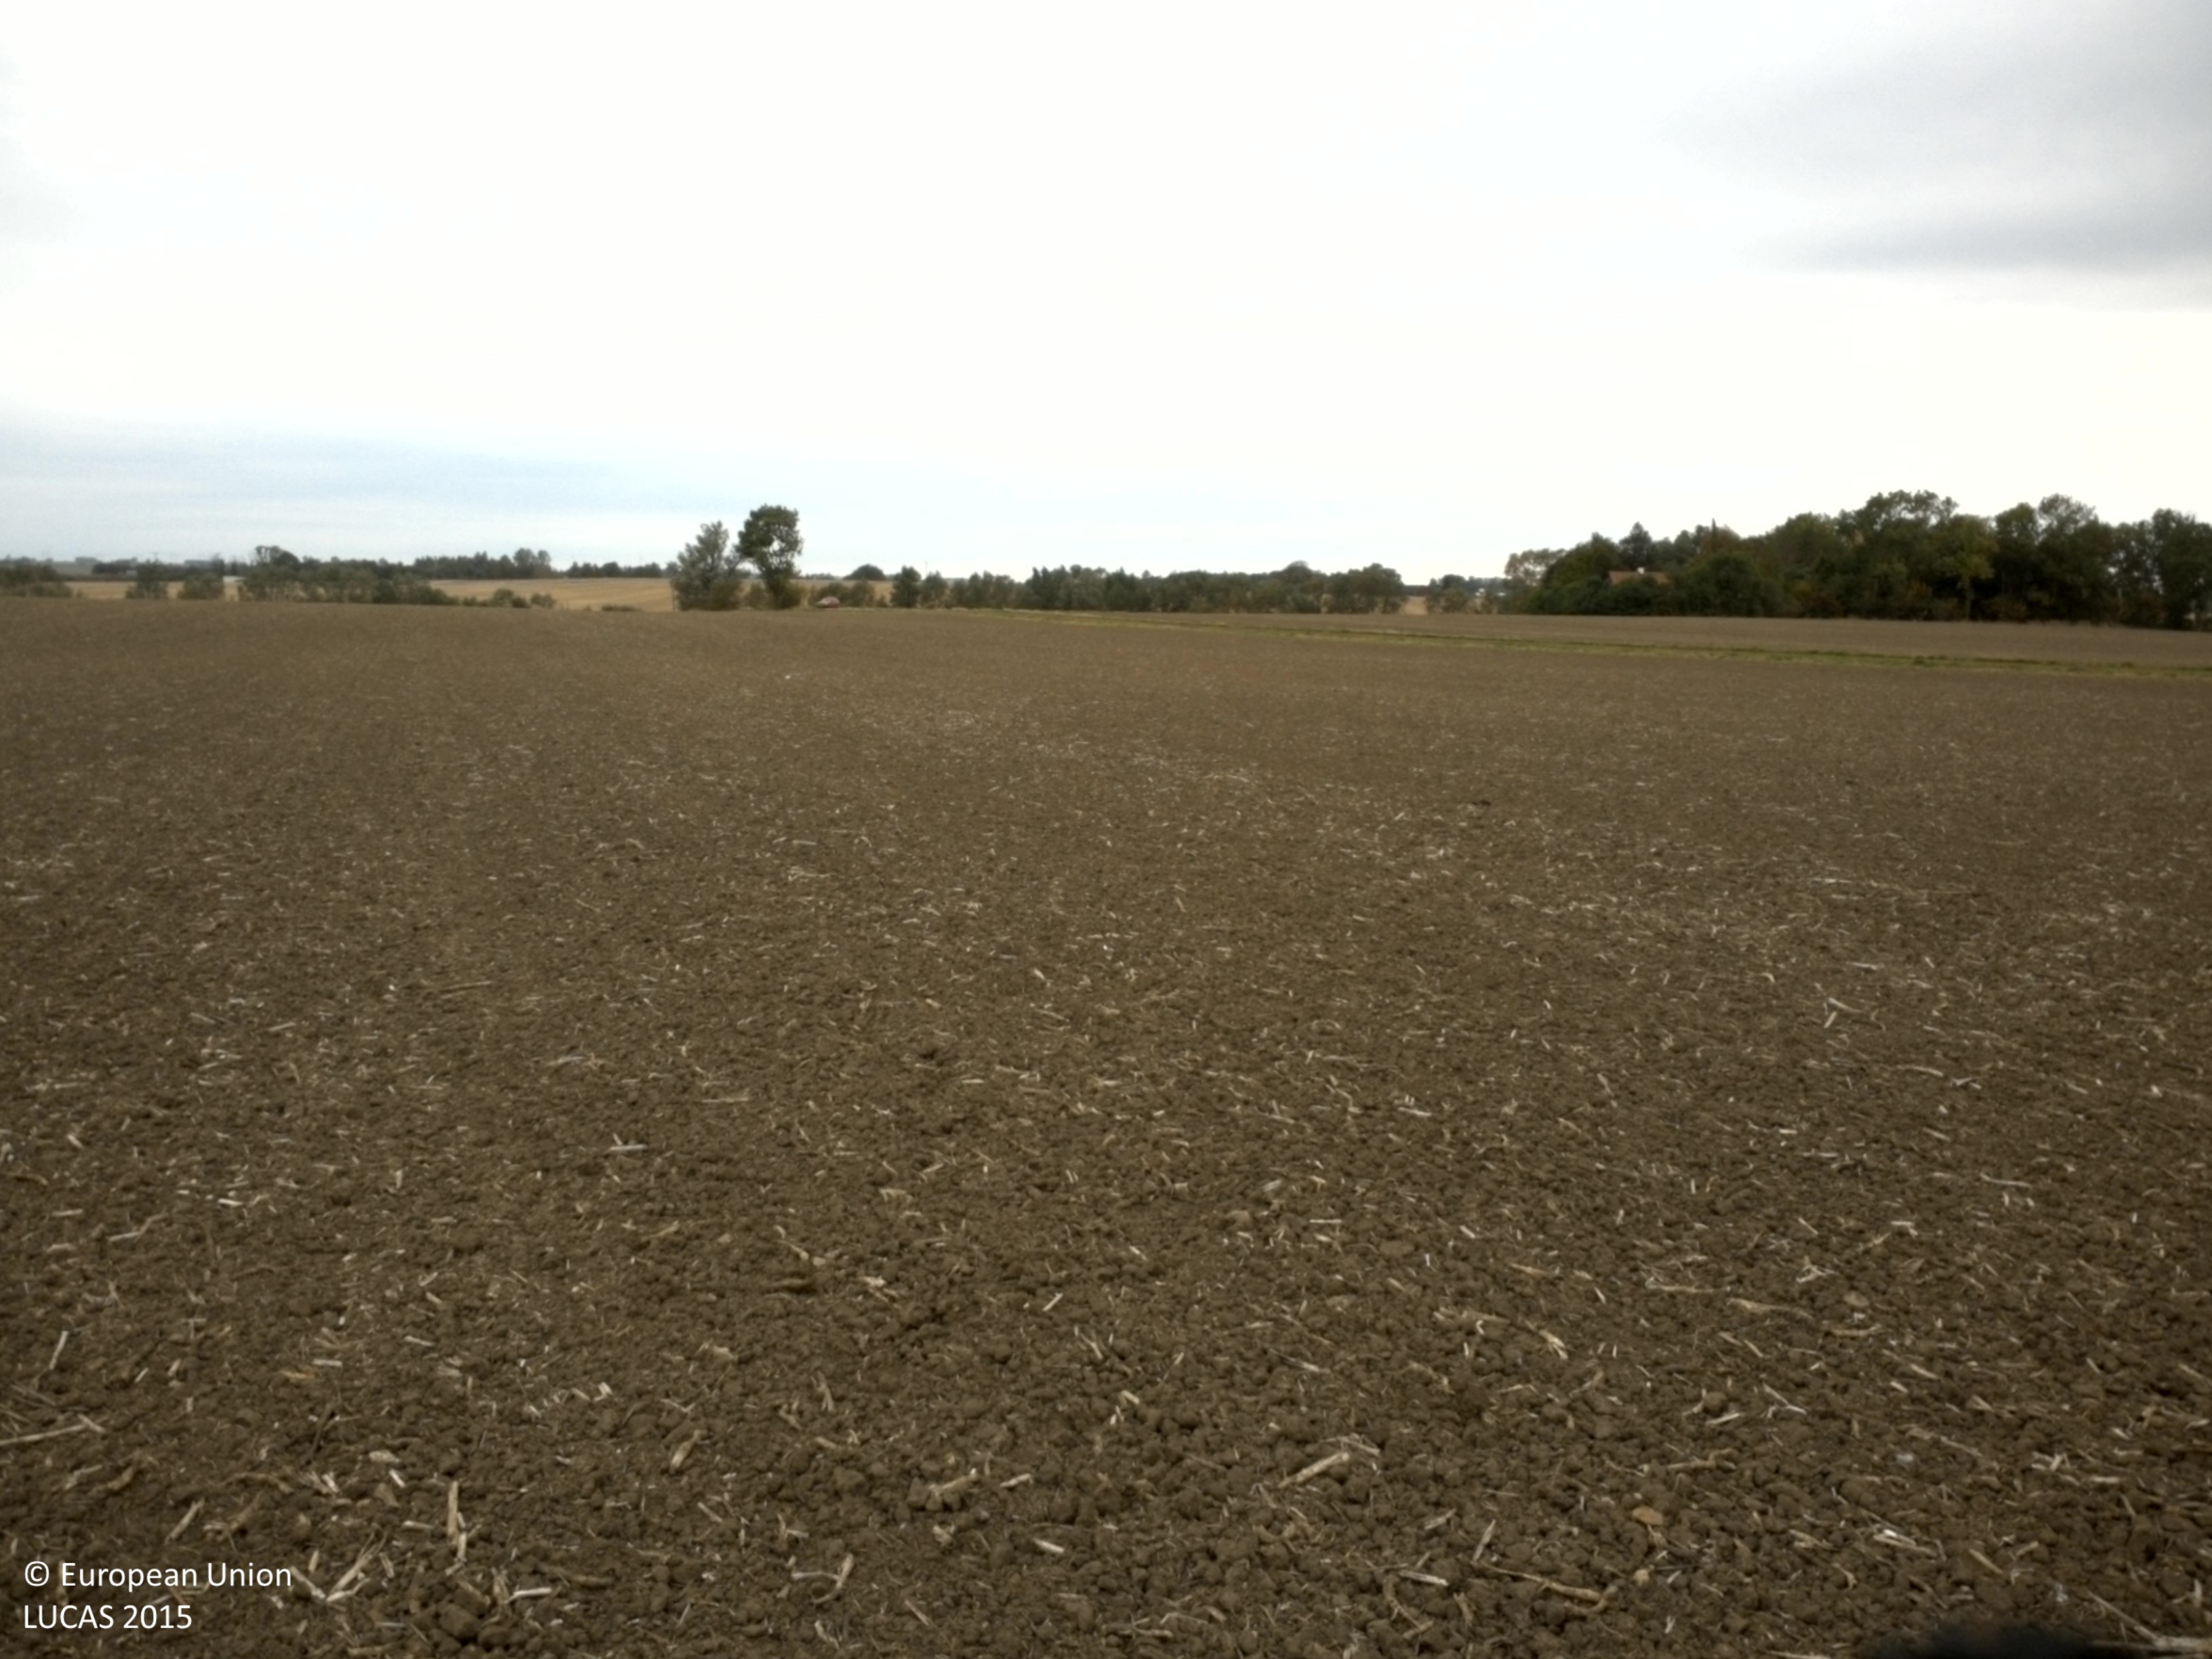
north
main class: Cropland
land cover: Common wheat
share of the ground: < 10 %
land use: Agriculture (excluding fallow land and kitchen gardens)
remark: Tilled/Sowed
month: October
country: SE
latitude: 55.8450
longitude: 13.0801
